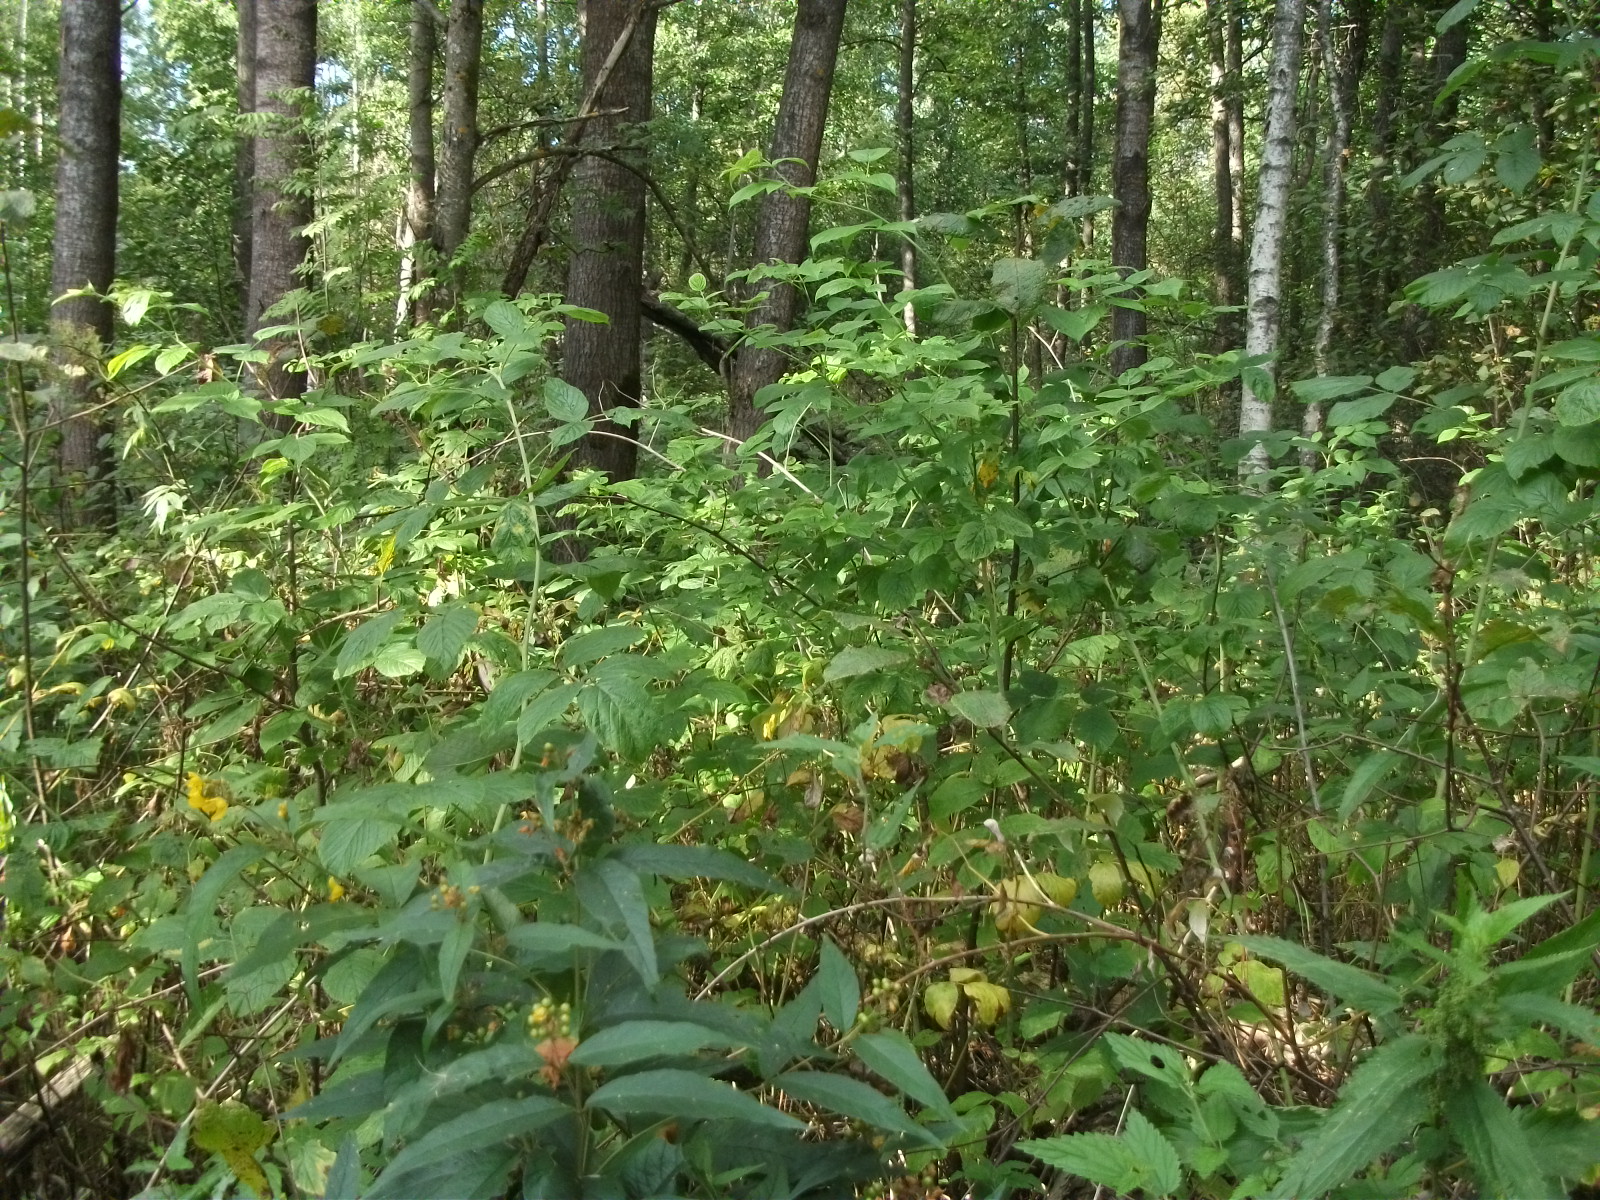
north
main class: Woodland
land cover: Broadleaved woodland
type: non-riverine alder, birch or aspen forest
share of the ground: > 75 %
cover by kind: broadleaved forest trees 80 %, shrubs 10 %, herbaceous plants 10 %
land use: Forestry
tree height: > 5 m
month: August
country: LV
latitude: 56.3961
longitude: 26.3615
